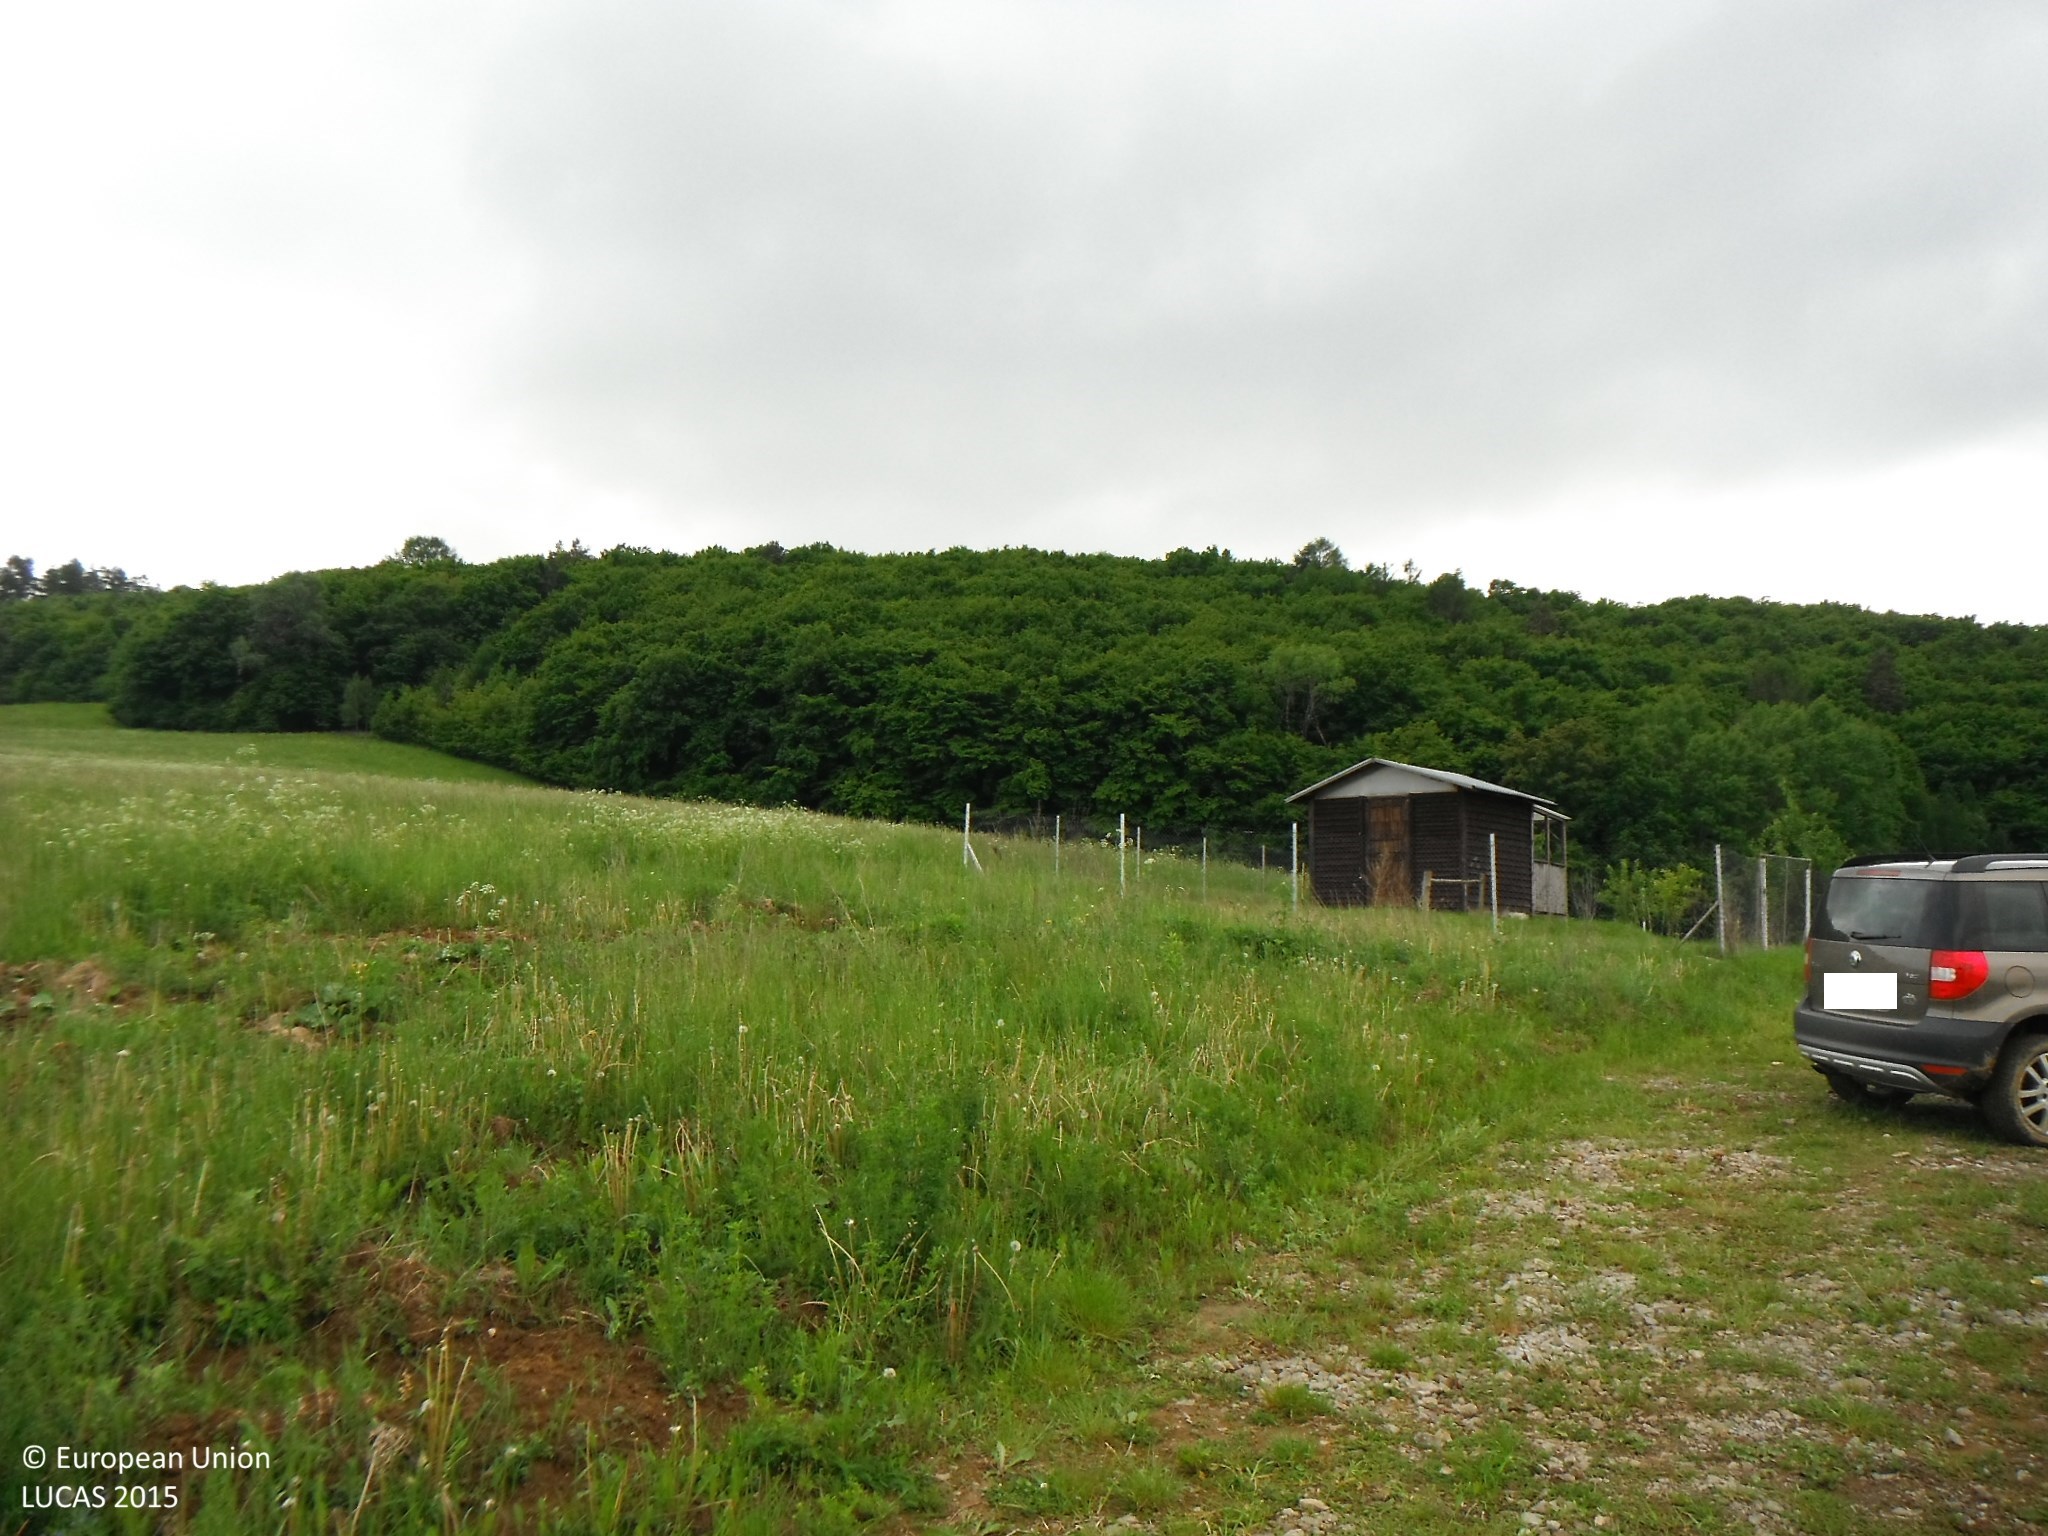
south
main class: Artificial land
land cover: Non built-up linear features
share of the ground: > 75 %
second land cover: Spontaneously vegetated surfaces
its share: 25 - 50 %
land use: Road transport
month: May
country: SK
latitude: 49.0675
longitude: 21.1999
